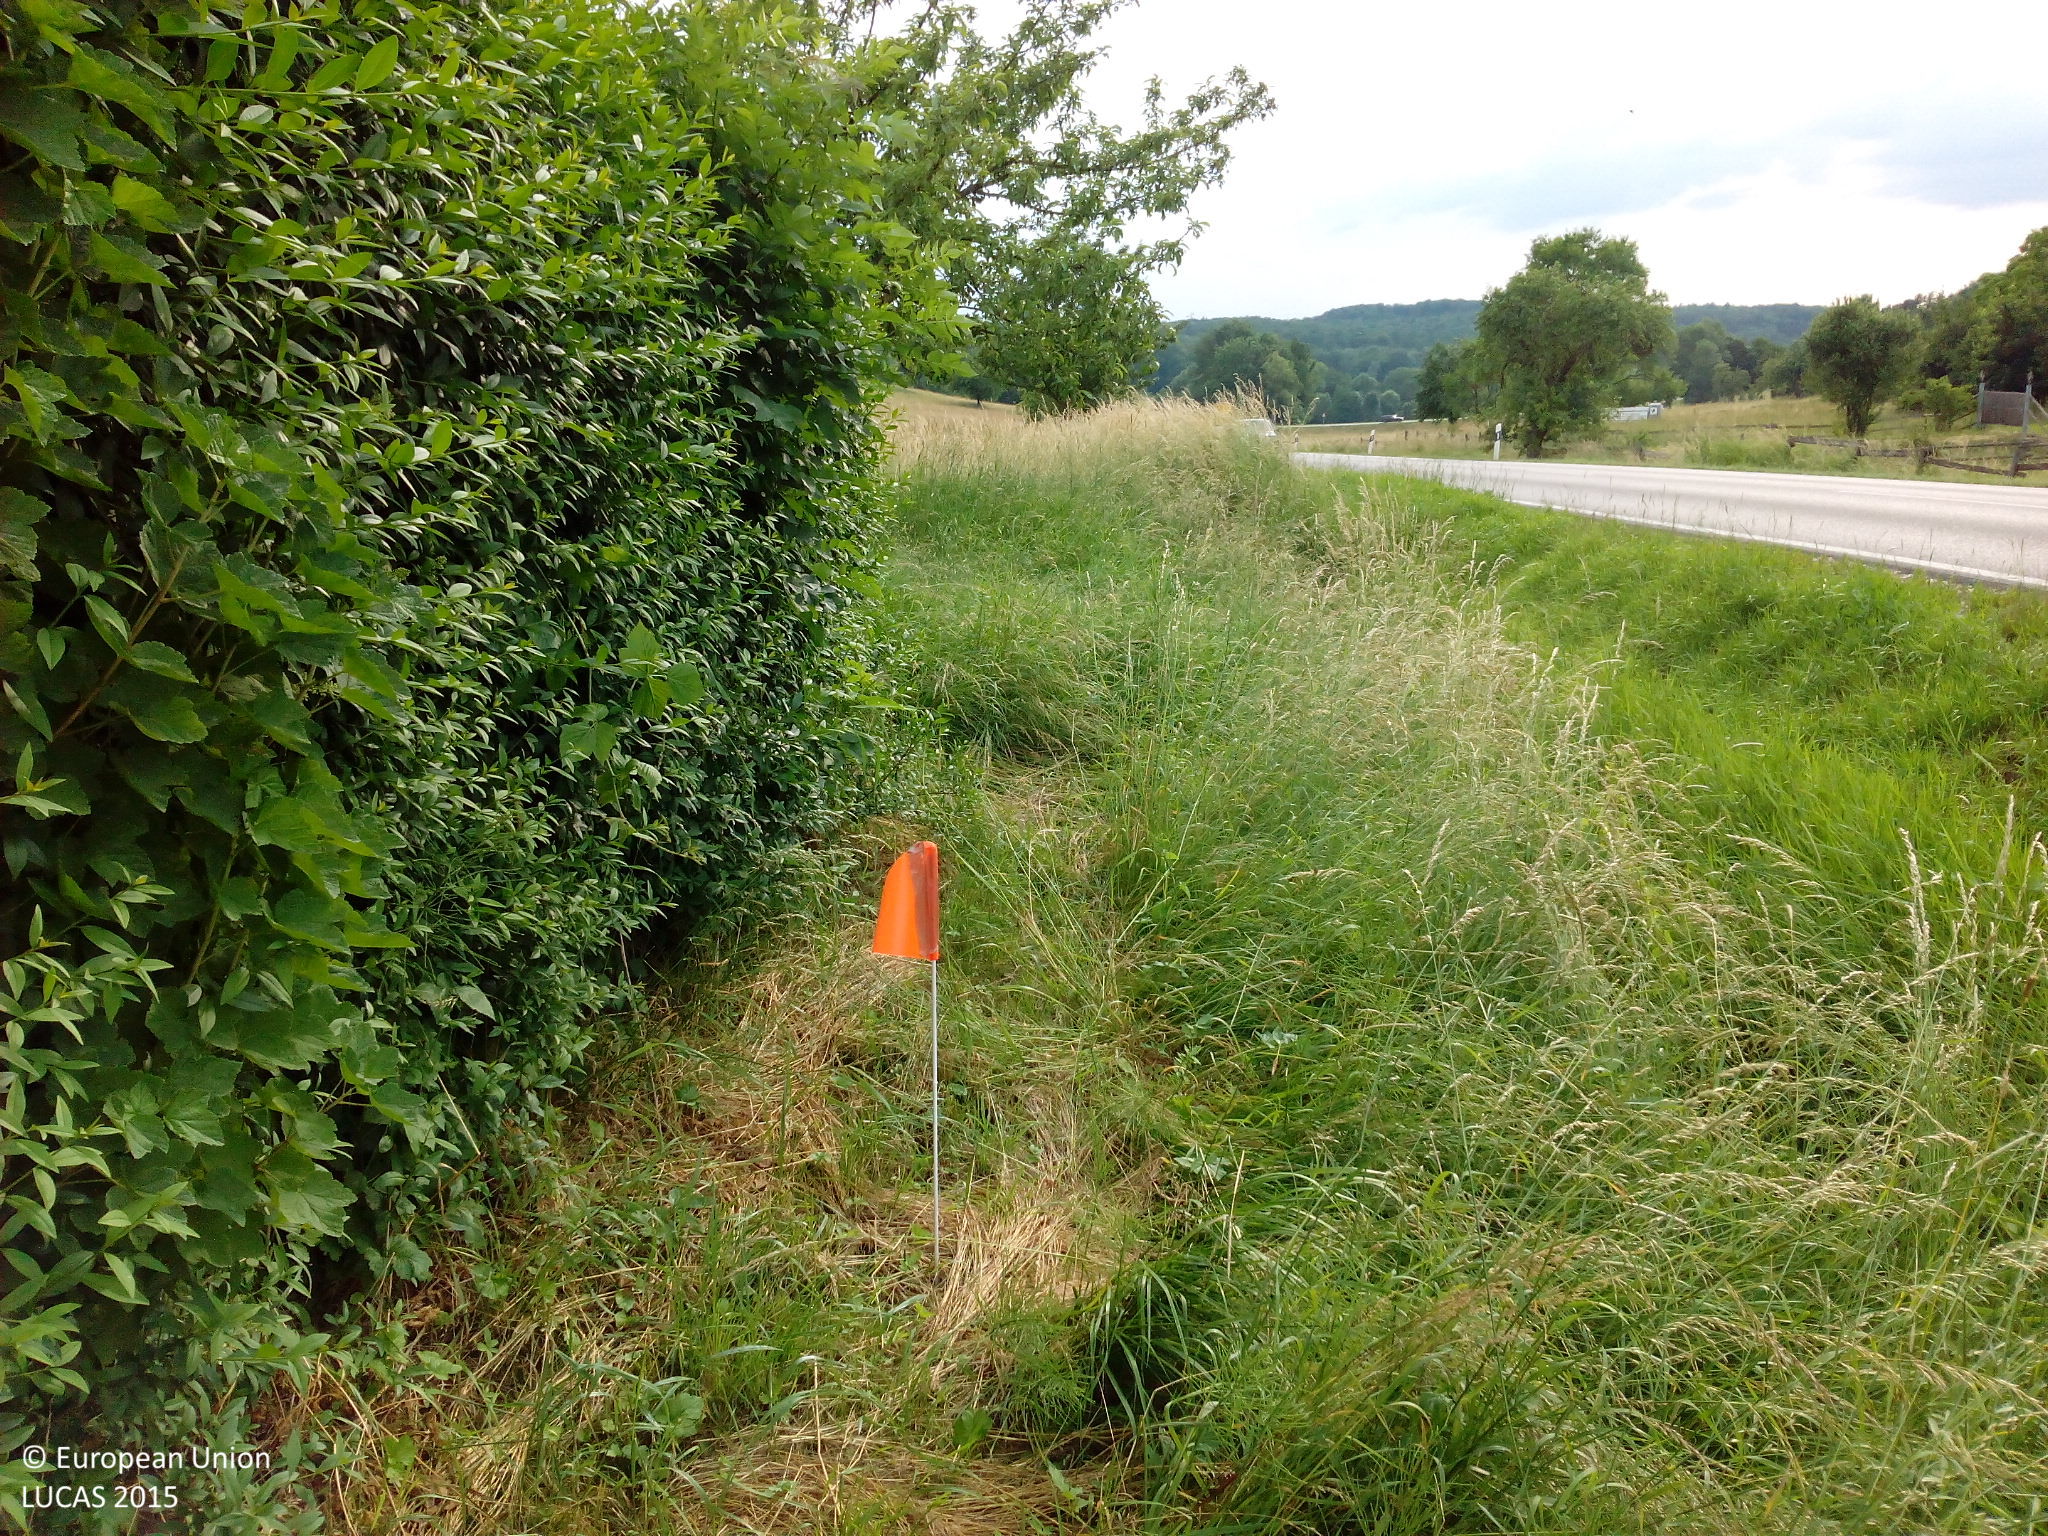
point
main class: Grassland
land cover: Grassland without tree/shrub cover
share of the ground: > 75 %
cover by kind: herbaceous plants 100 %
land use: Semi-natural and natural areas not in use
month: June
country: DE
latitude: 48.6358
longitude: 9.4168
